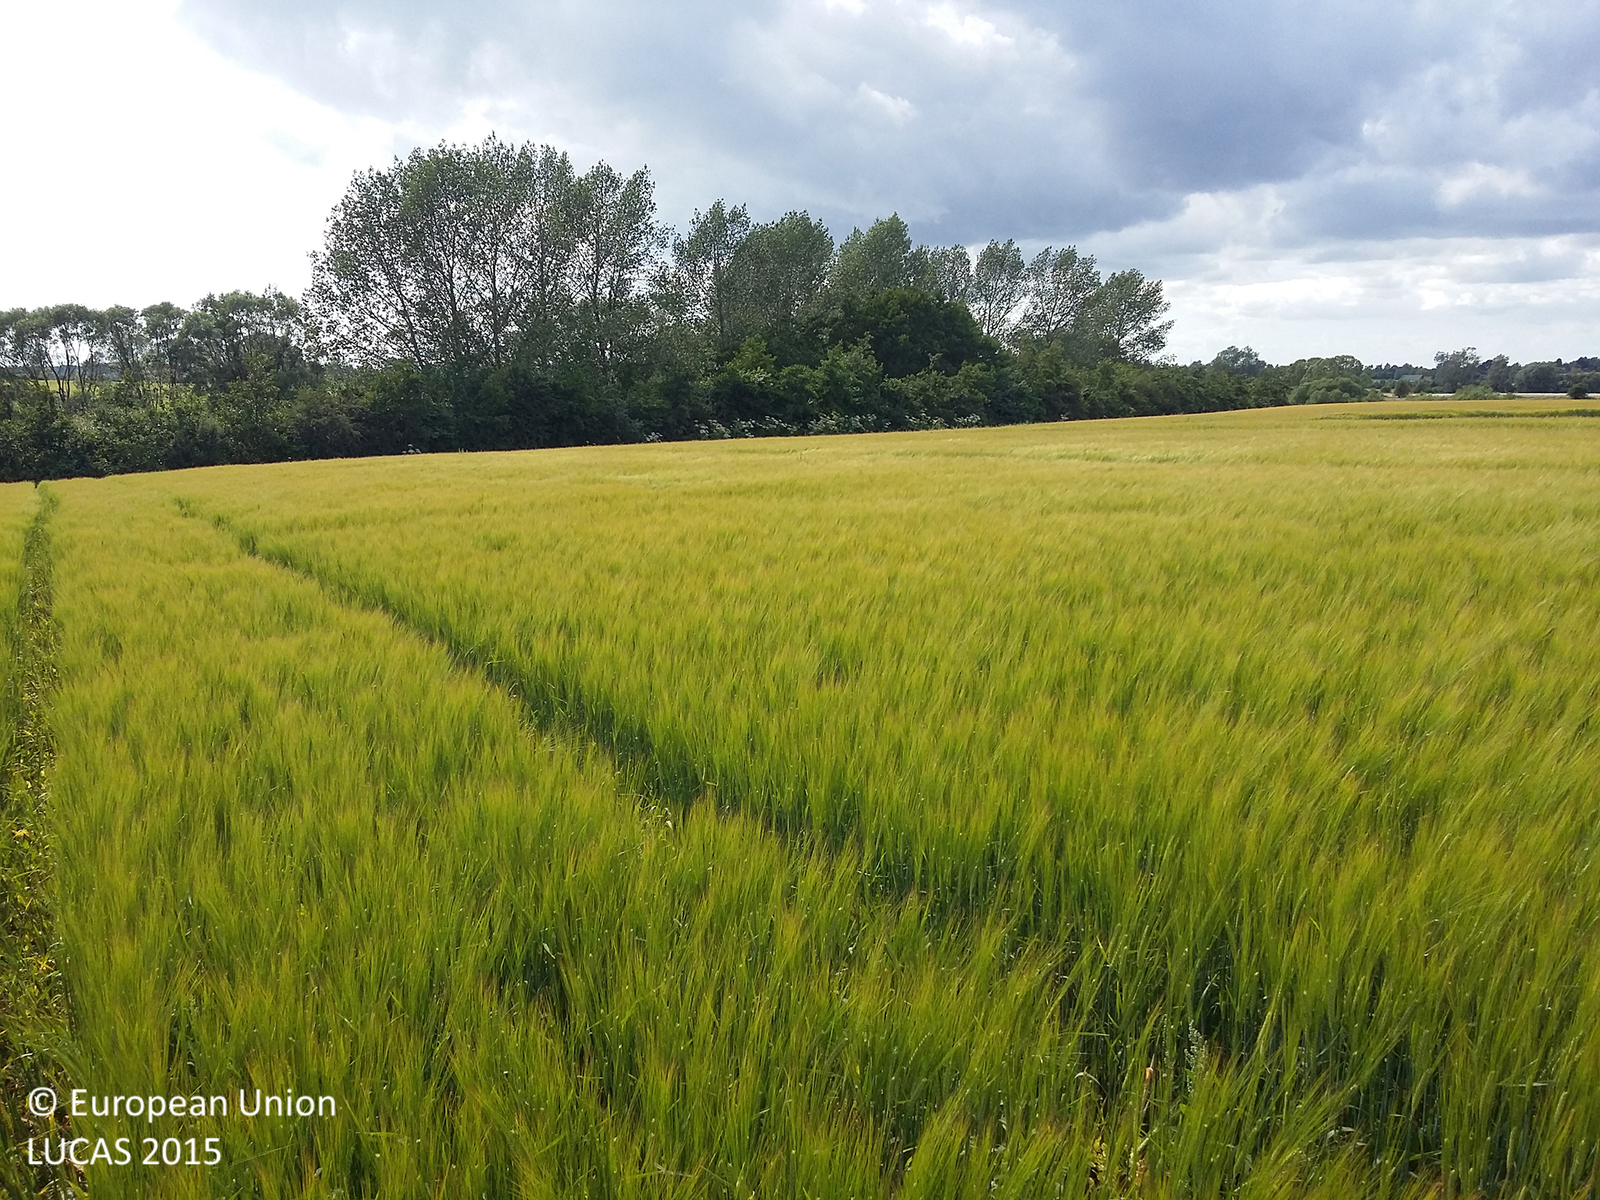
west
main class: Cropland
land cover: Barley
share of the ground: > 75 %
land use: Agriculture (excluding fallow land and kitchen gardens)
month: July
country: DK
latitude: 55.1867
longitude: 11.7735
